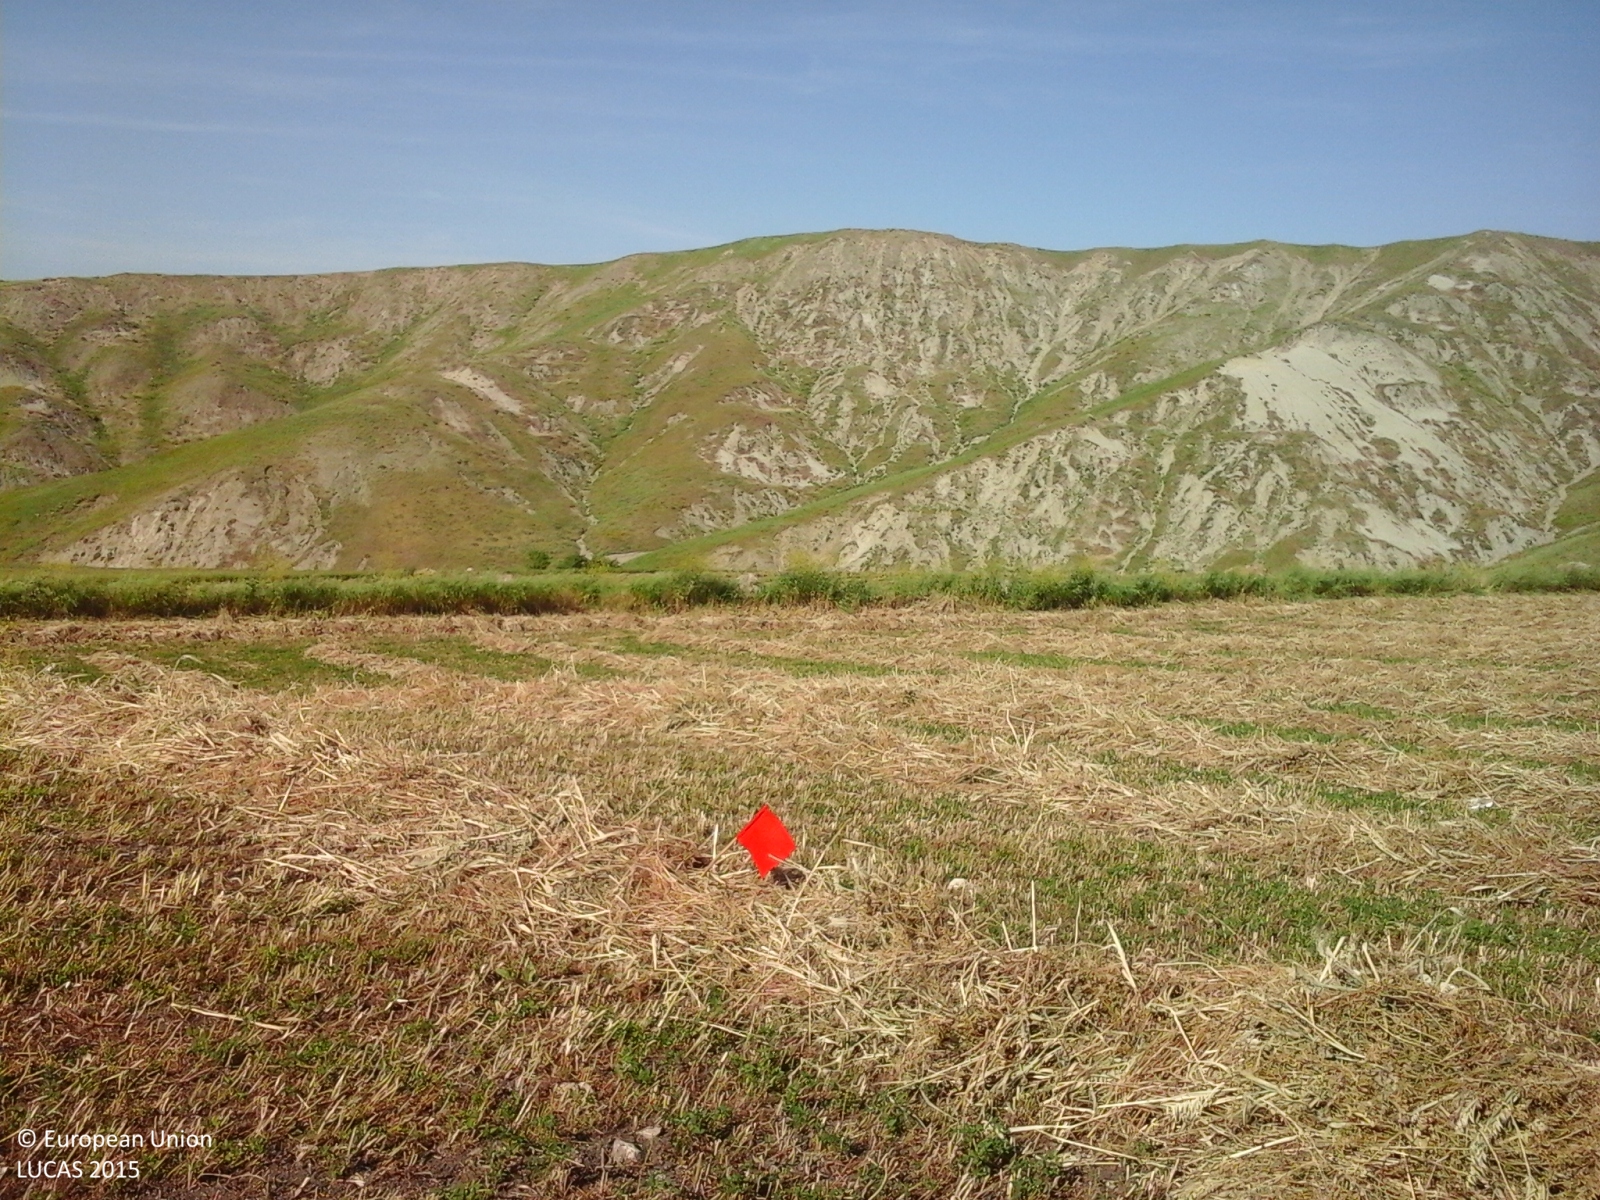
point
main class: Cropland
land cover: Clovers
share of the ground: > 75 %
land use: Agriculture (excluding fallow land and kitchen gardens)
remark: Harvested field
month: May
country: IT
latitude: 37.6292
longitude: 13.9481
